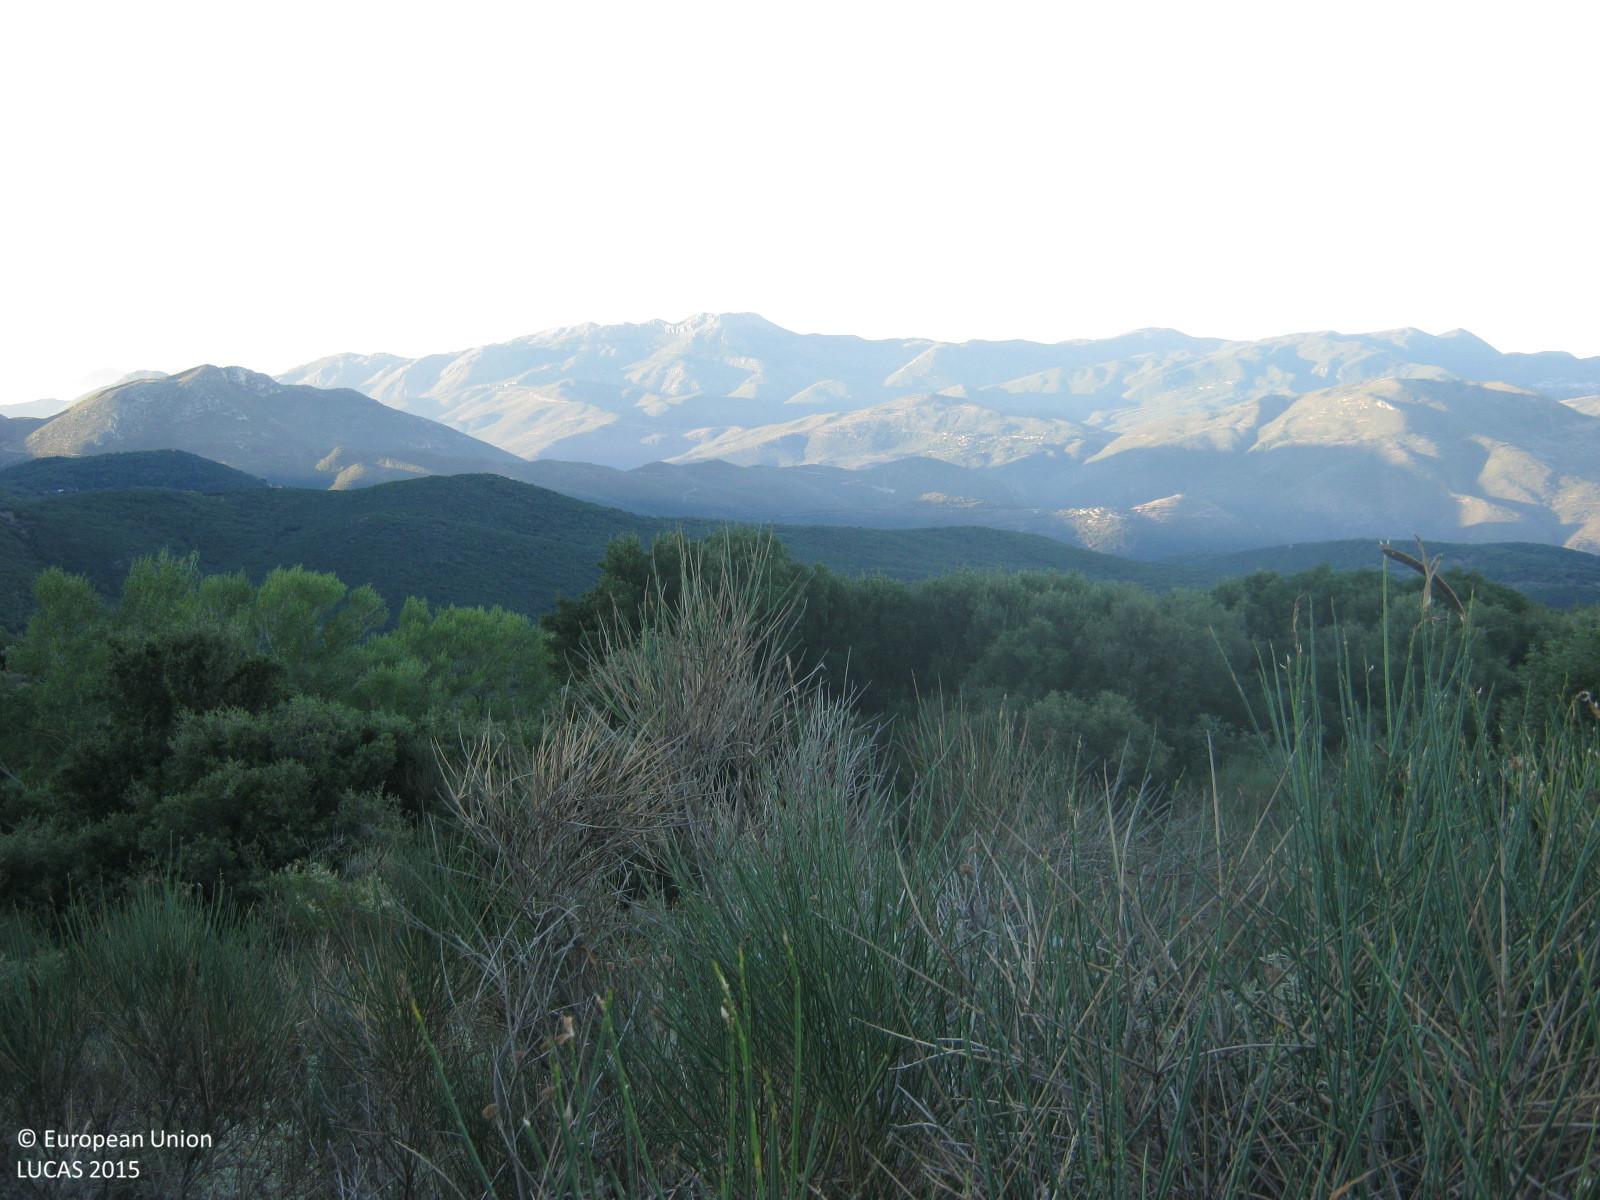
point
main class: Shrubland
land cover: Shrubland with sparse tree cover
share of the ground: > 75 %
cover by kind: shrubs 95 %, broadleaved forest trees 5 %
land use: Semi-natural and natural areas not in use
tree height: > 5 m
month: September
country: GR
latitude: 37.5920
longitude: 21.9767
